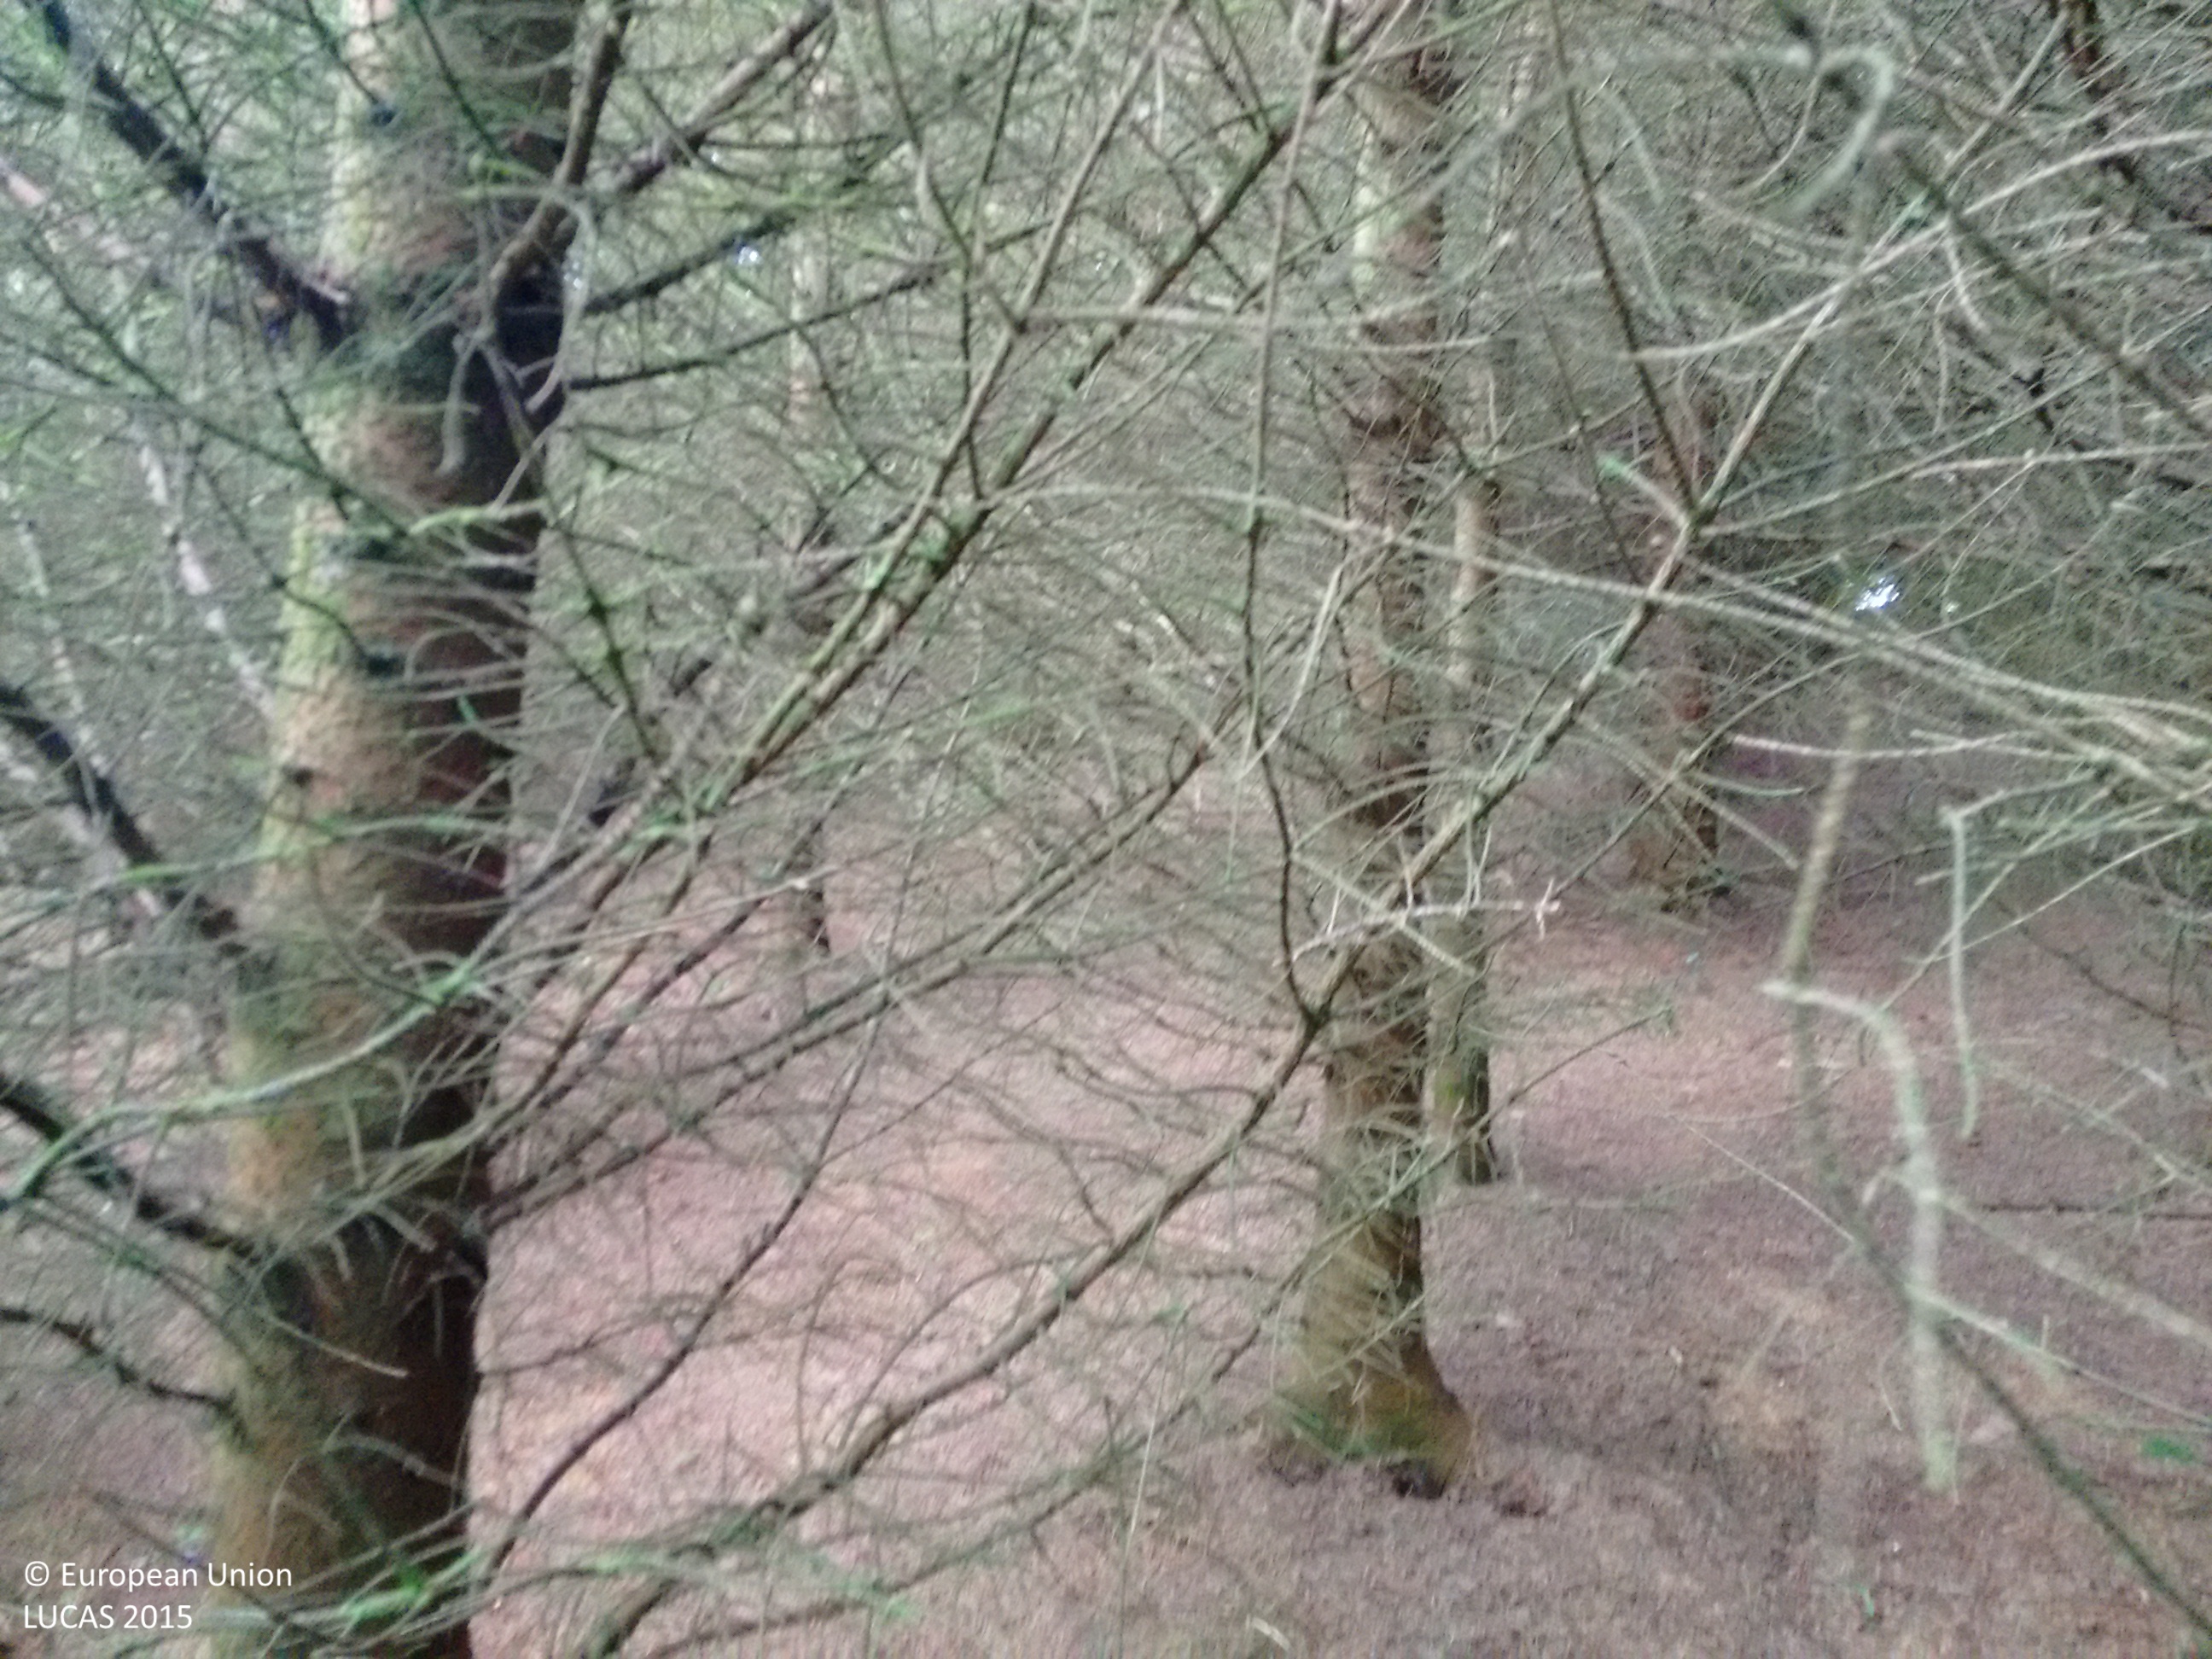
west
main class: Woodland
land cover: Spruce dominated coniferous woodland
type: exotic forest
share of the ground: > 75 %
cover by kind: coniferous forest trees 100 %
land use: Forestry
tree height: > 5 m
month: September
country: IE
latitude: 55.0210
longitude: -7.4030
